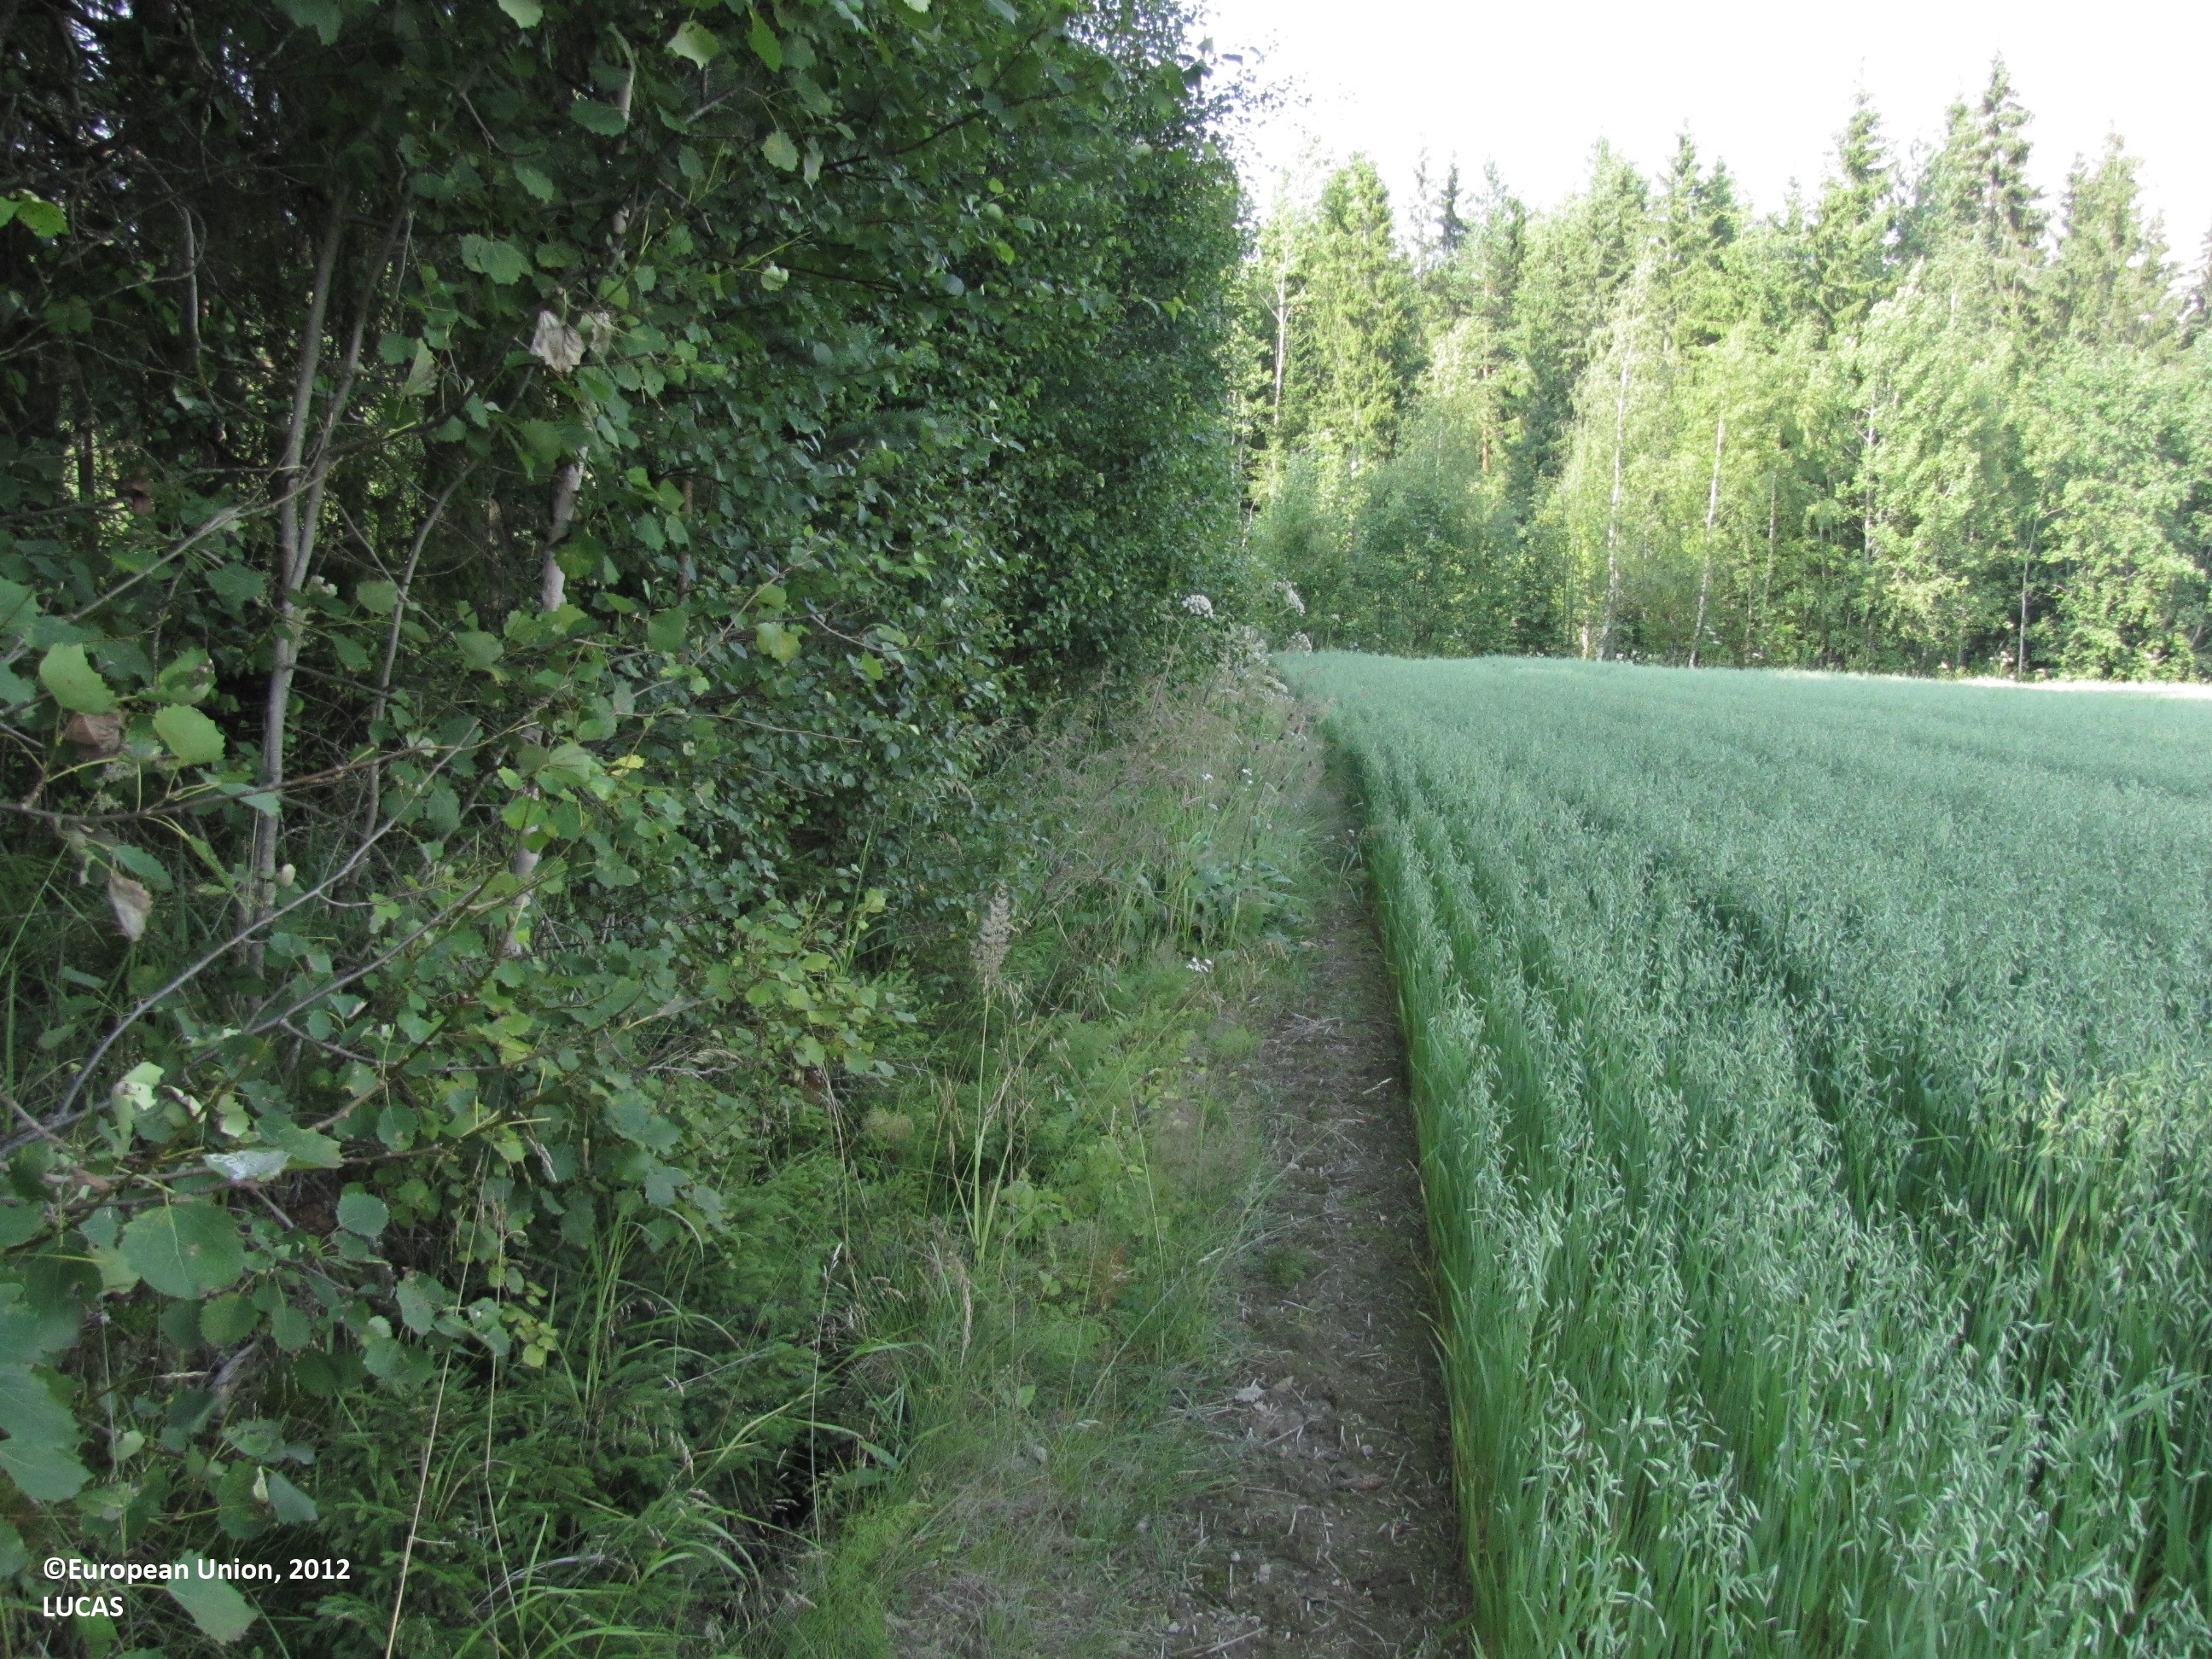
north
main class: Cropland
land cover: Oats
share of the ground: > 75 %
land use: Agriculture (excluding fallow land and kitchen gardens)
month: July
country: FI
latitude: 61.9564
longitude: 22.9751
